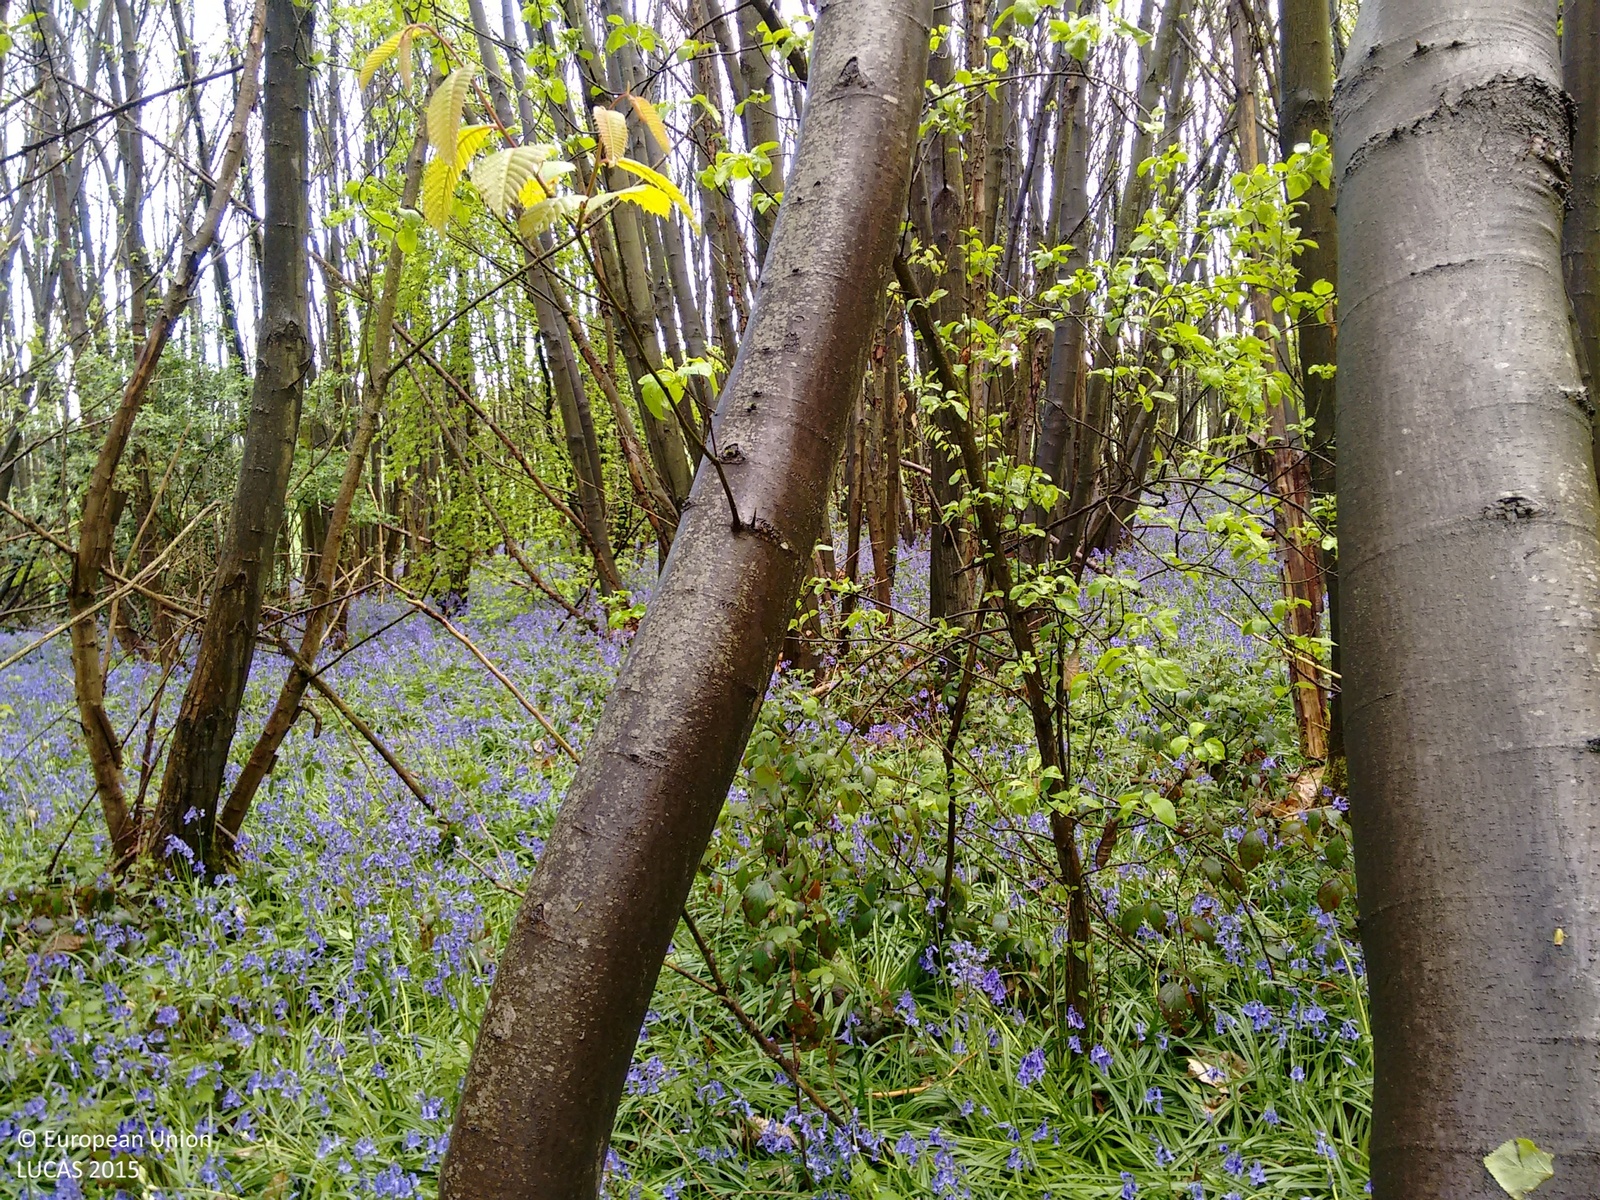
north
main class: Woodland
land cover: Broadleaved woodland
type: mesophytic deciduous forest
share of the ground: > 75 %
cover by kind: broadleaved forest trees 100 %
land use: Forestry
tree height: > 5 m
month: May
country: GB
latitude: 51.3212
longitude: 0.2263
